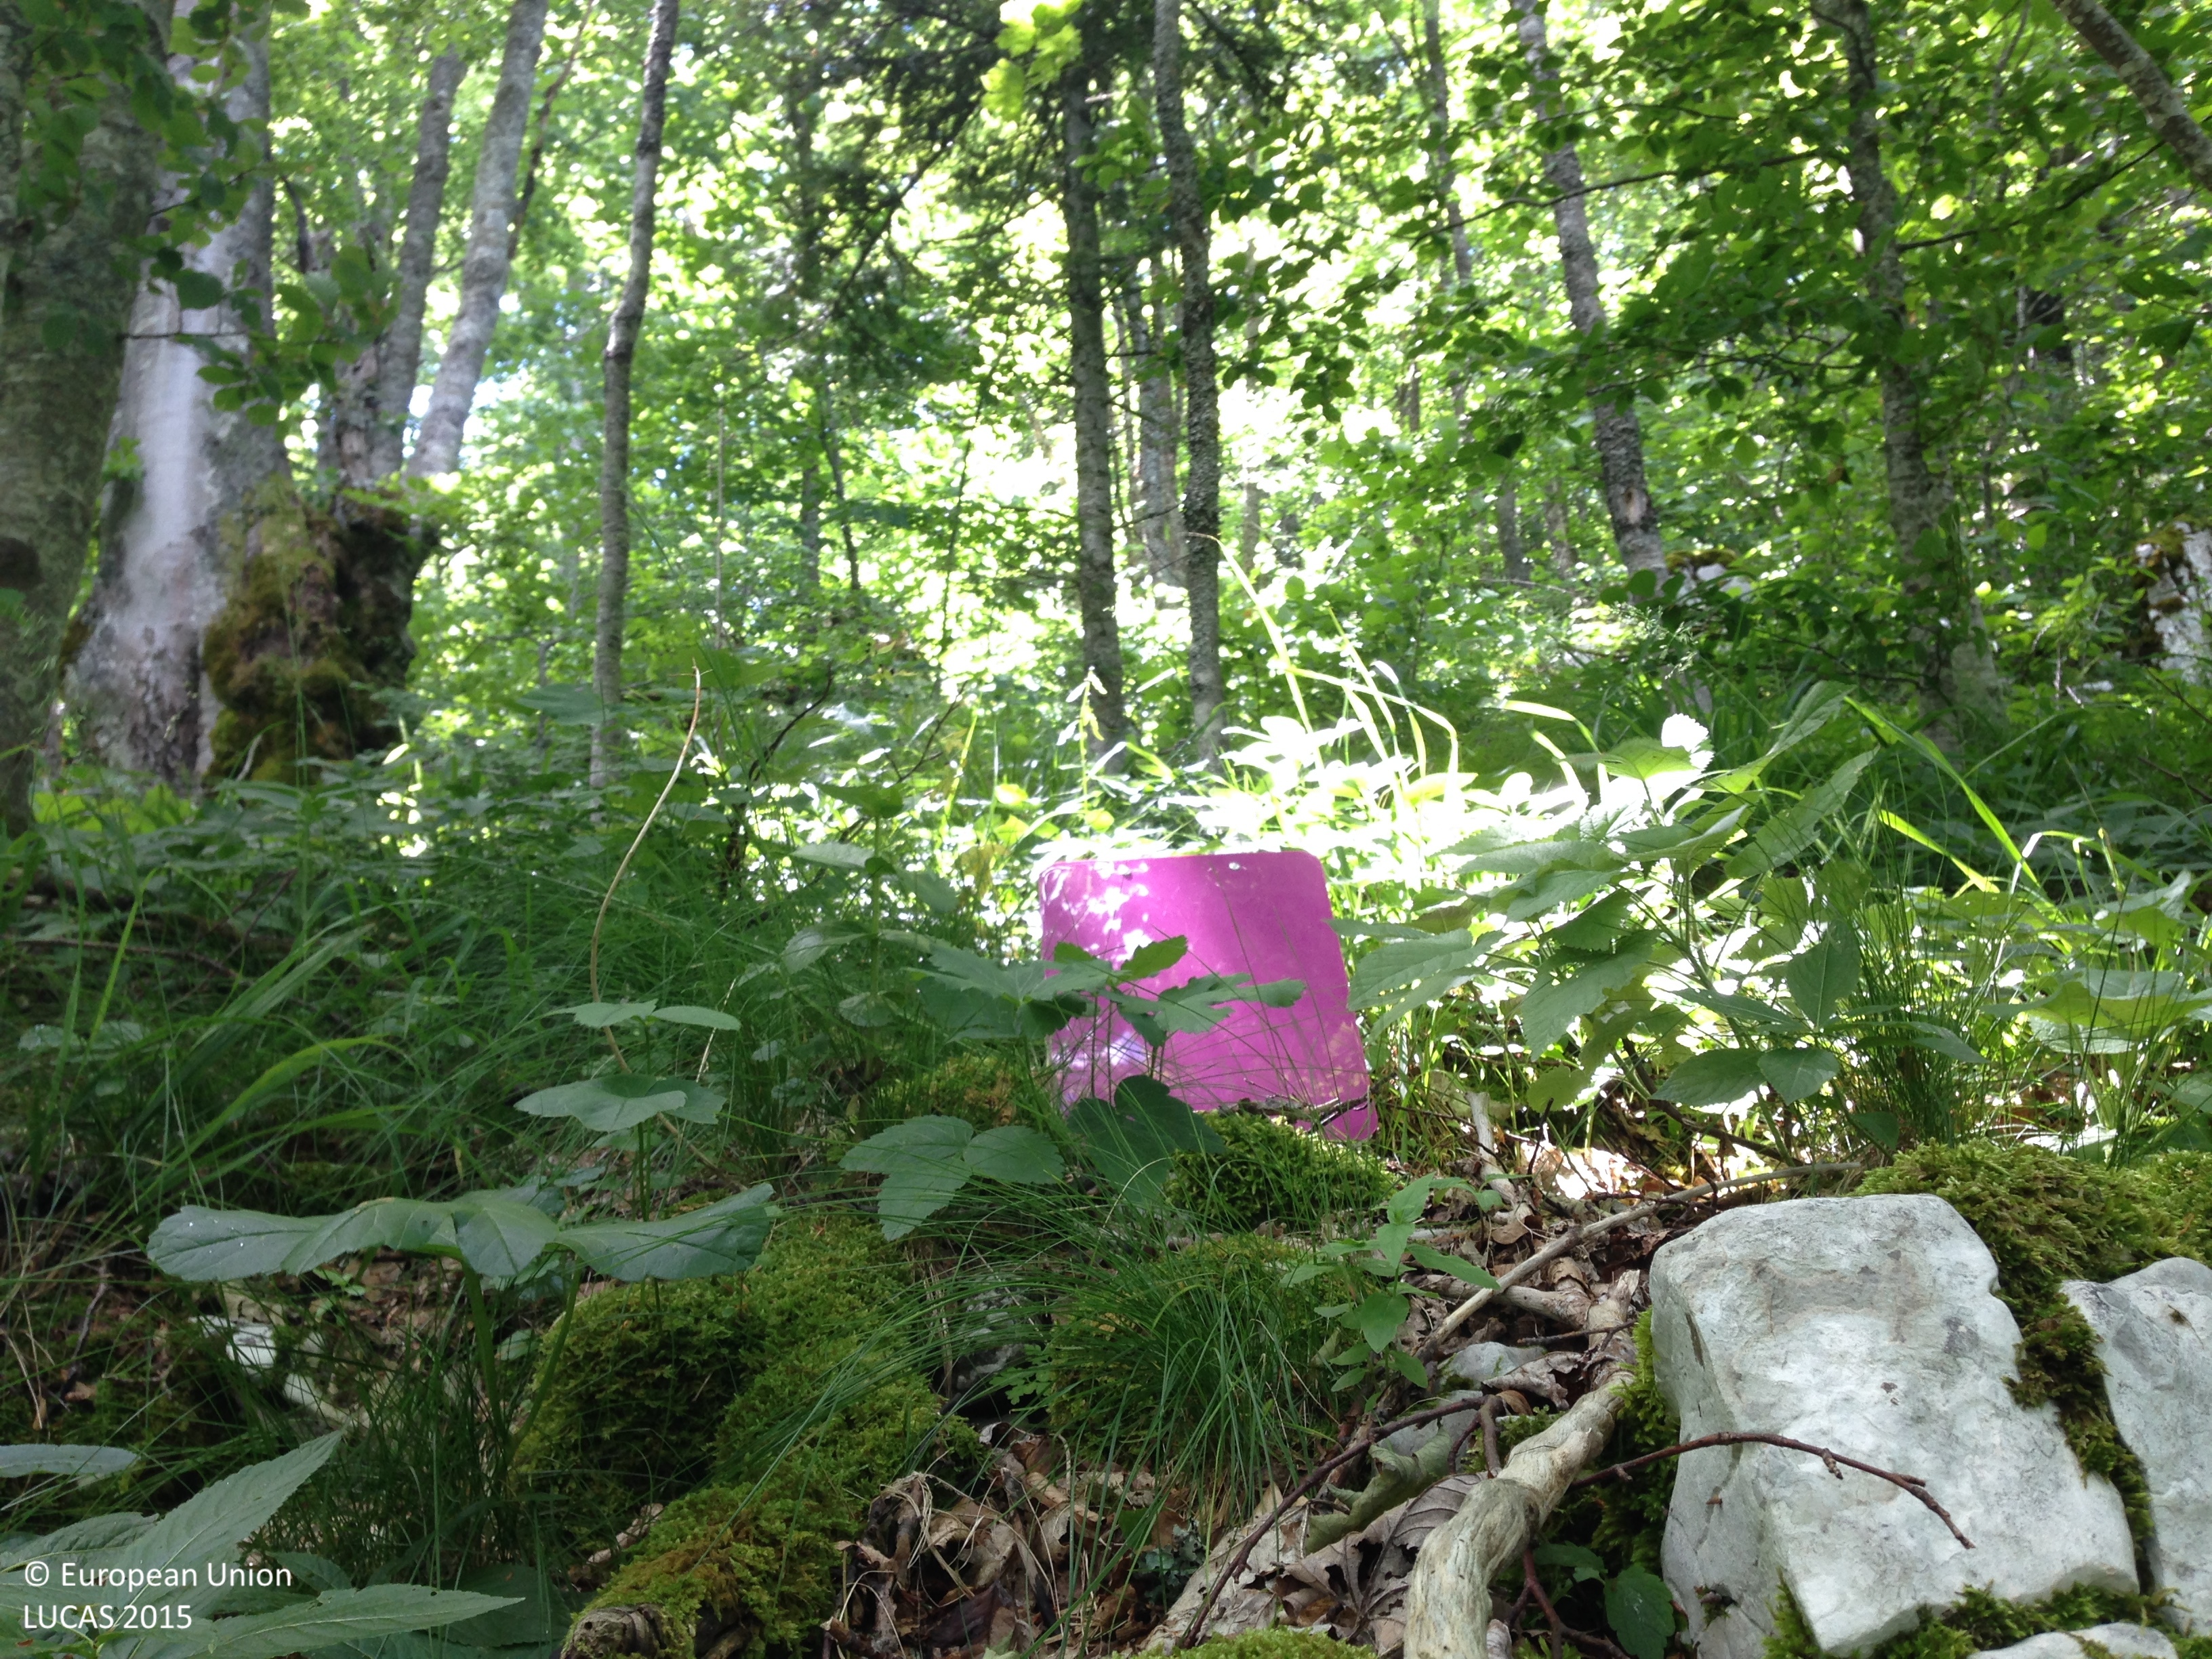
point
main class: Woodland
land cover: Broadleaved woodland
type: thermophilous deciduous forest
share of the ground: > 75 %
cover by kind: broadleaved forest trees 75 %, herbaceous plants 10 %, shrubs 5 %, consolidated bare surface 5 %, unconsolidated bare surface 5 %
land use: Forestry
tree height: > 5 m
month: June
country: HR
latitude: 44.6716
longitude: 15.8850
